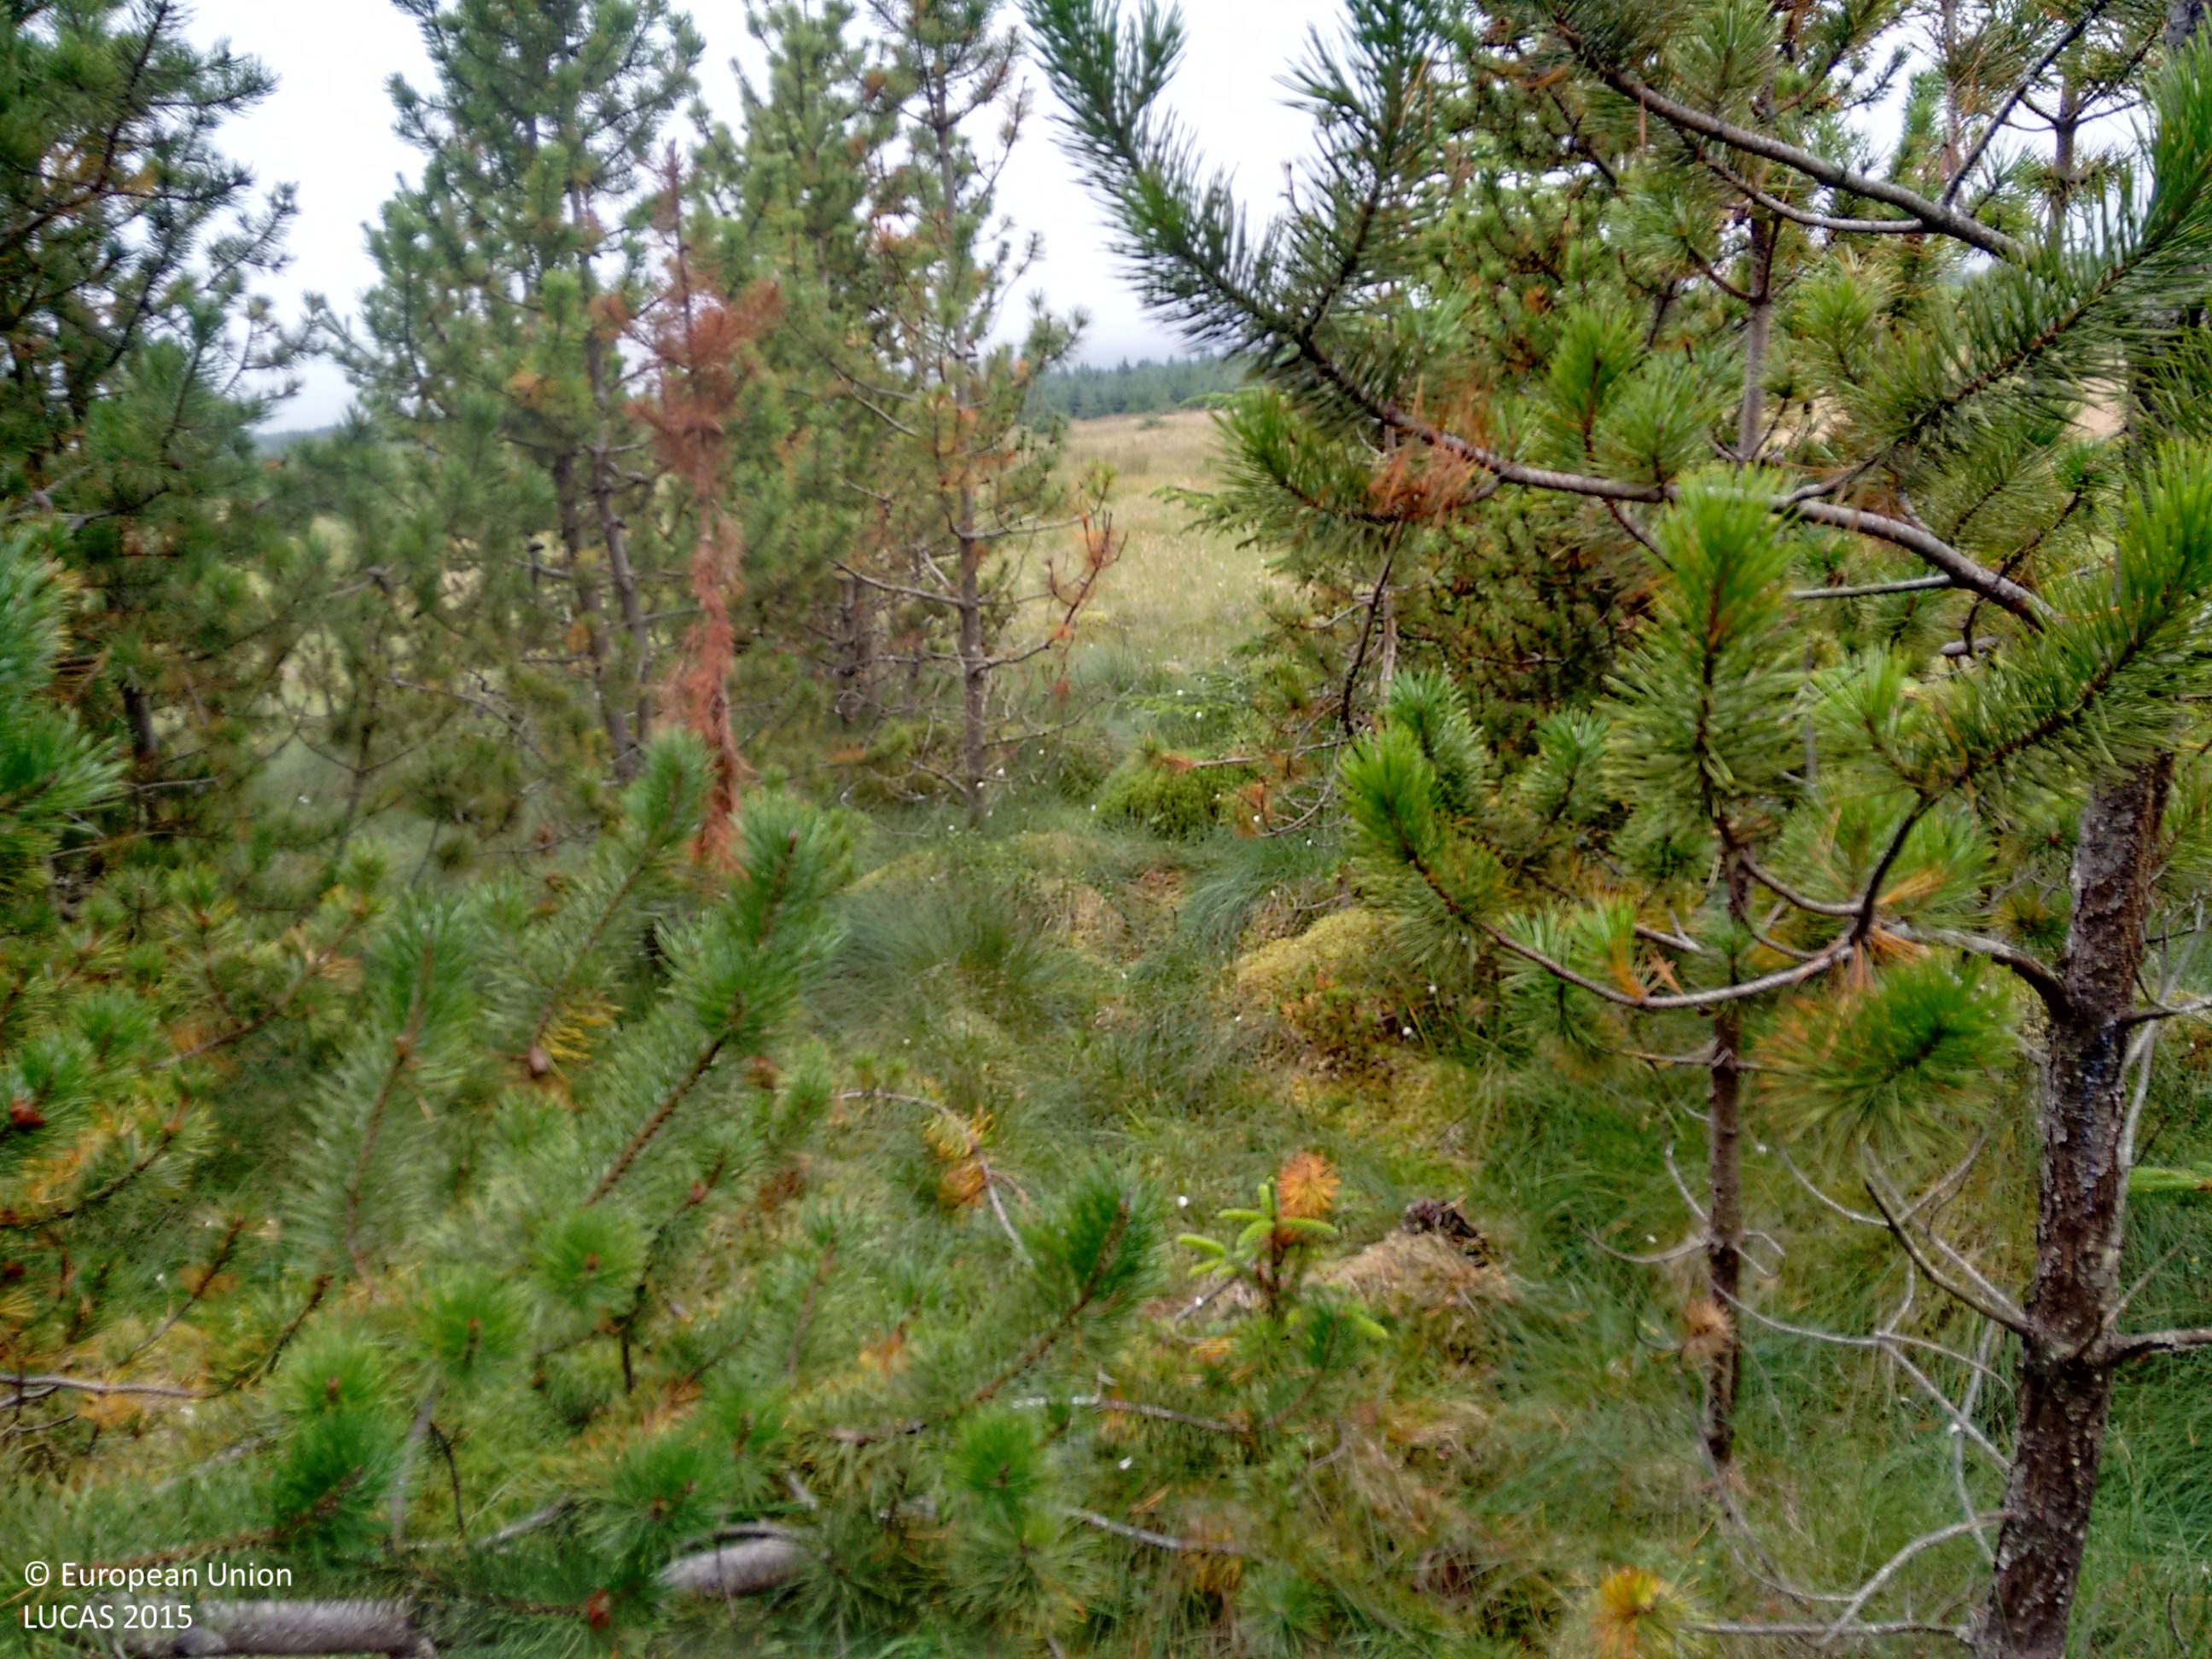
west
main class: Woodland
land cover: Pine dominated coniferous woodland
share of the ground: > 75 %
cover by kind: coniferous forest trees 90 %, herbaceous plants 10 %
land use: Forestry
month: August
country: GB
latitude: 58.3193
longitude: -3.3271
